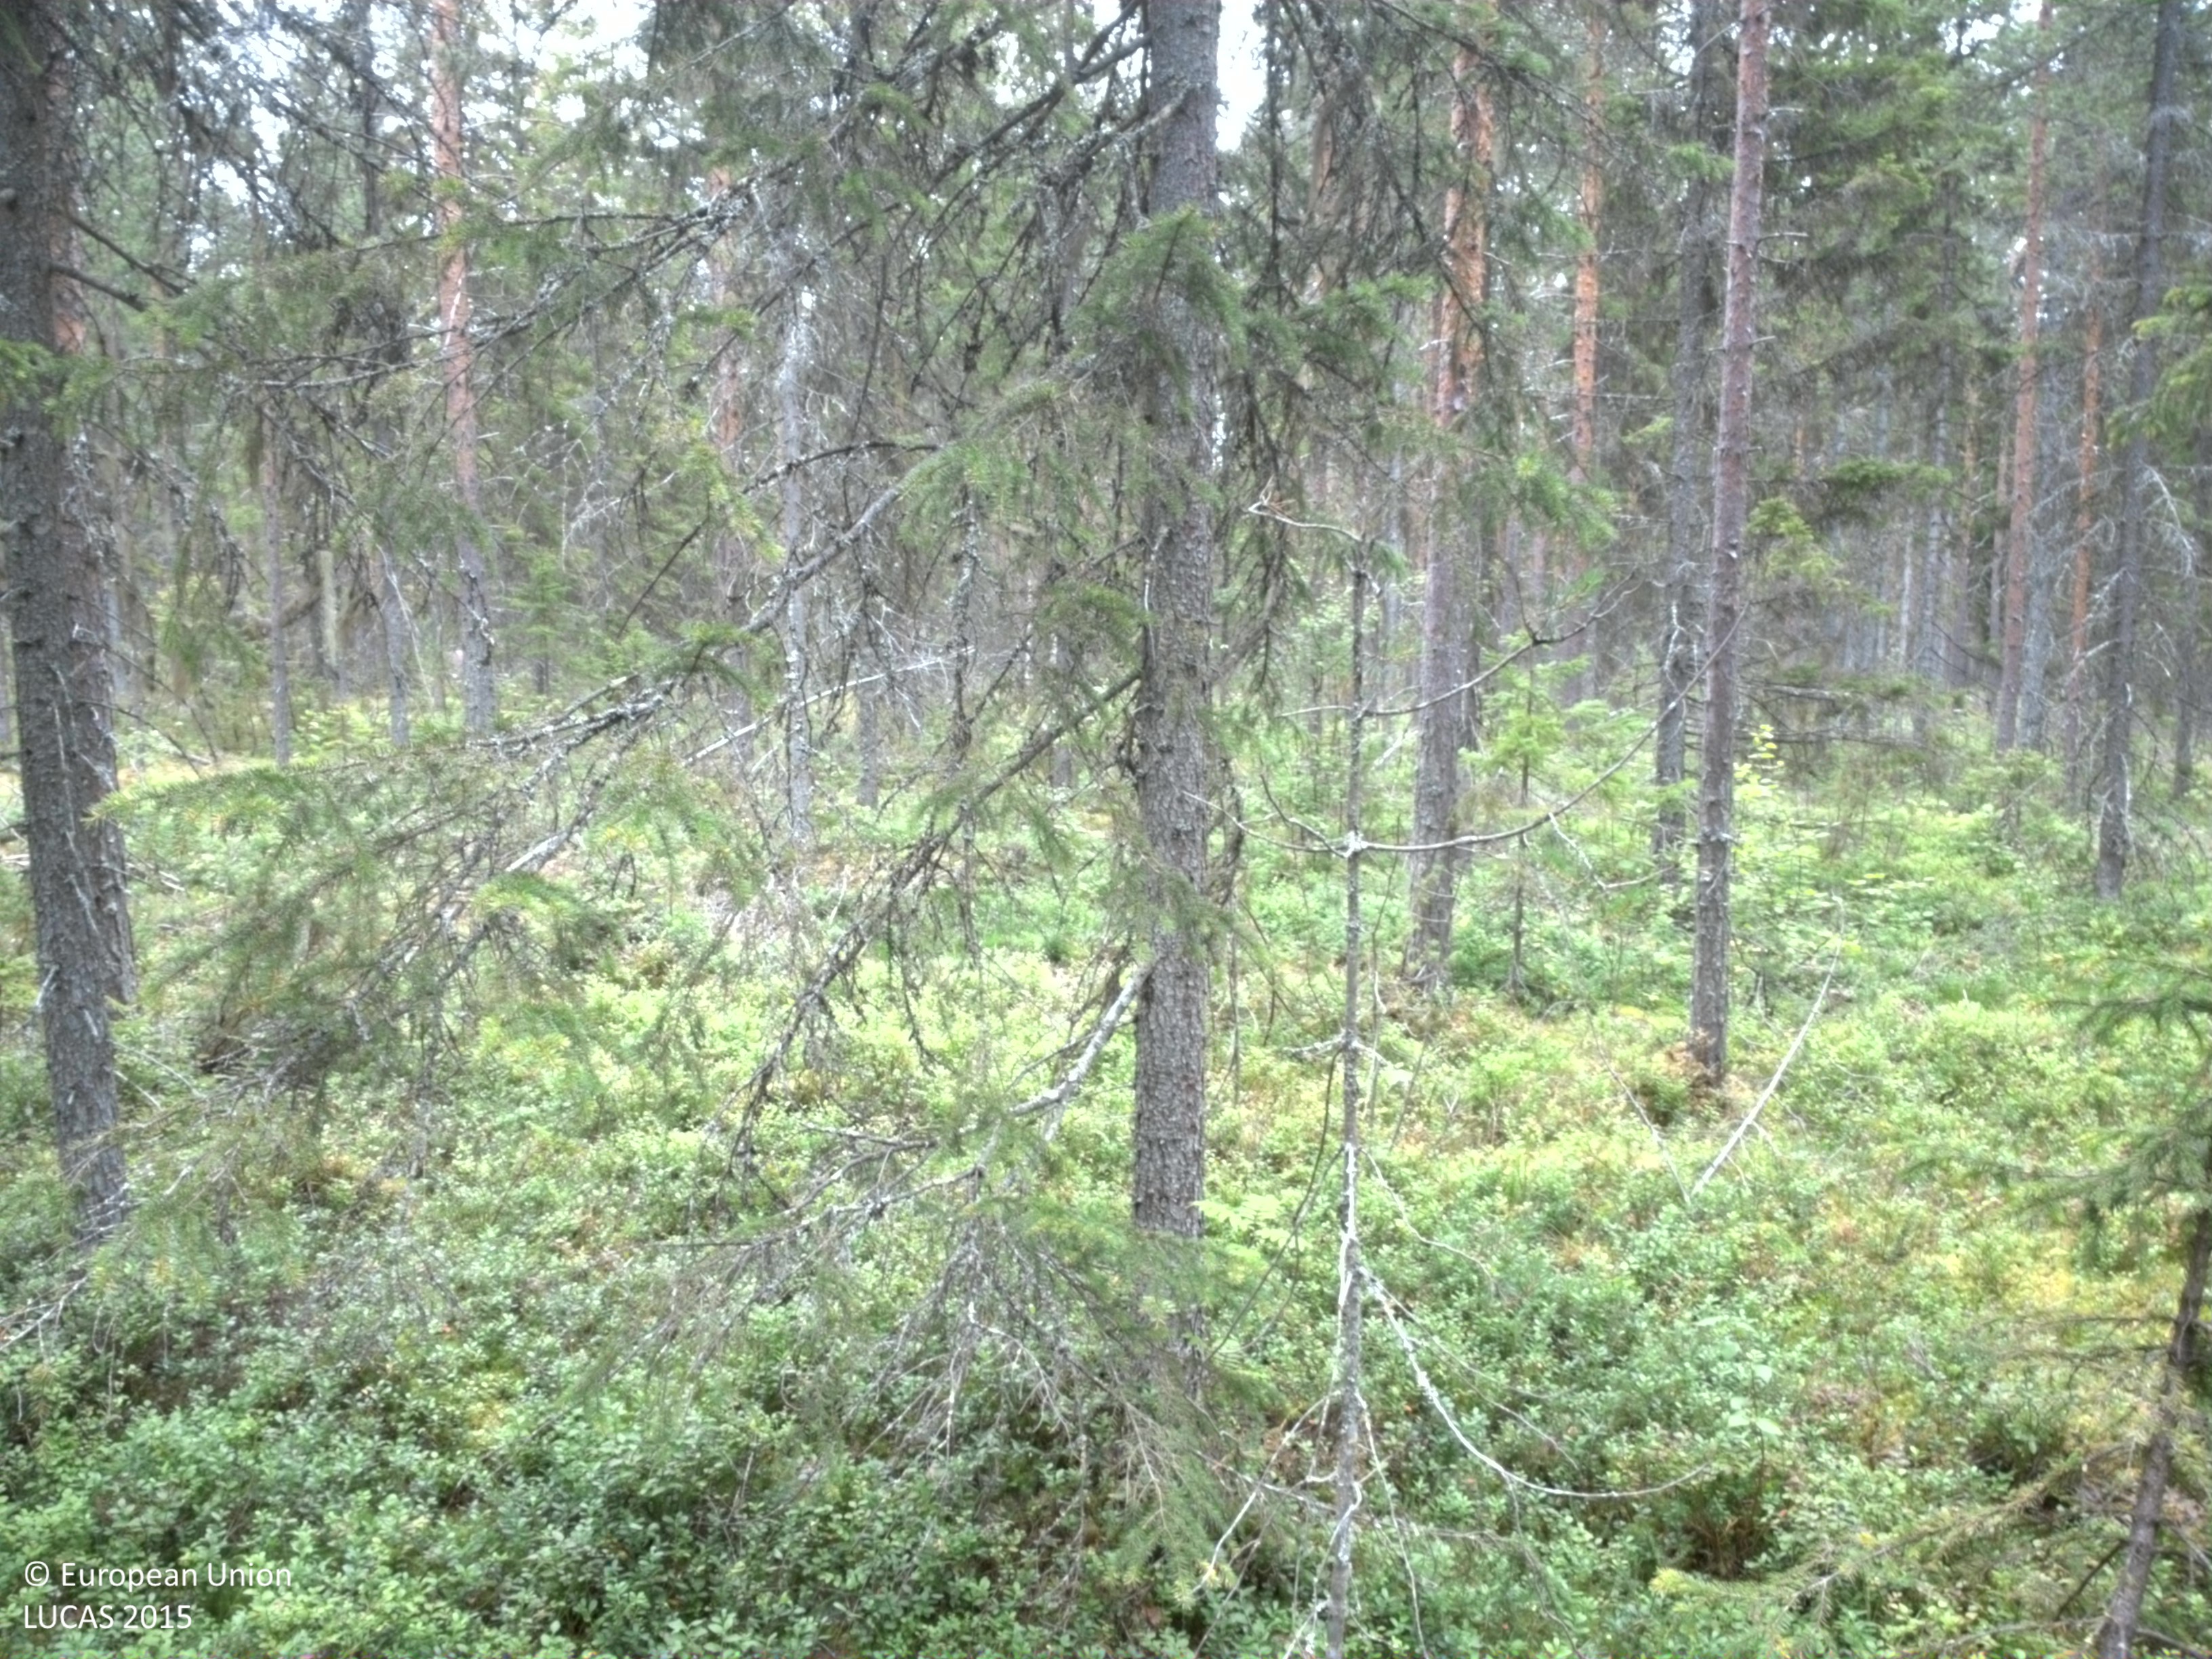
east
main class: Woodland
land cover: Pine dominated coniferous woodland
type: boreal forest
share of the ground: 50 - 75 %
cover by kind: coniferous forest trees 60 %, shrubs 30 %, broadleaved forest trees 5 %, lichens and mosses 5 %
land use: Forestry
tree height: > 5 m
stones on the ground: > 50 %
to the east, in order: Pine dominated coniferous woodland; Tracks; Pine dominated coniferous woodland; Paved roads, cycling and walking lanes; Pine dominated coniferous woodland
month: August
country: SE
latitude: 64.5662
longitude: 20.6836
